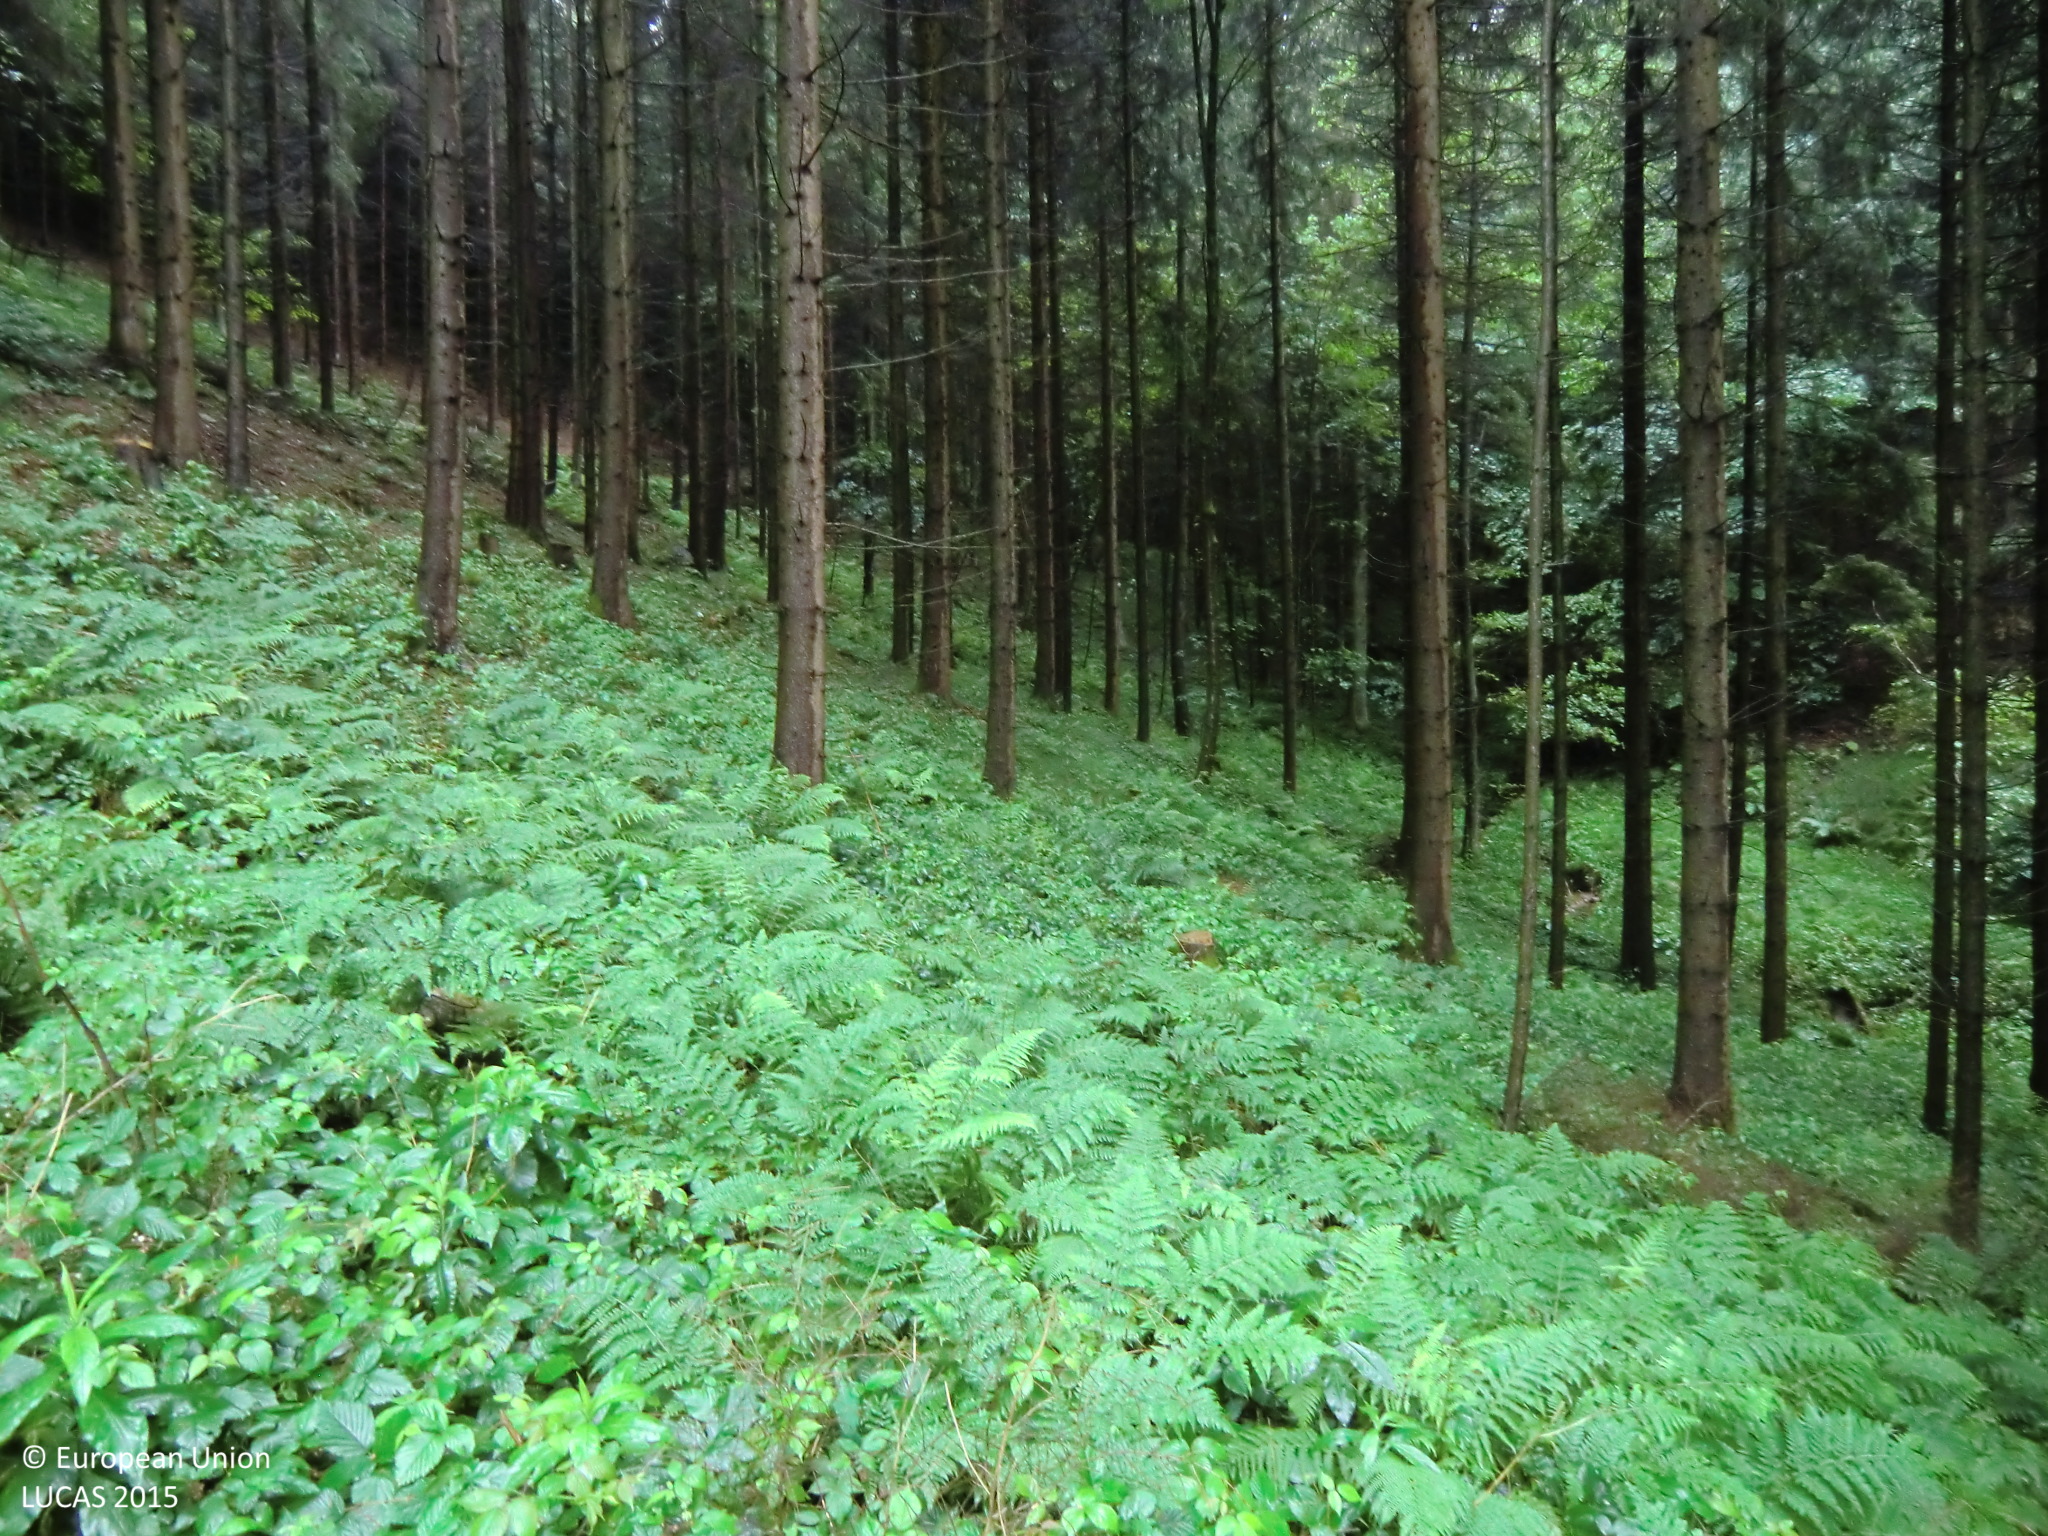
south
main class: Woodland
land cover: Spruce dominated coniferous woodland
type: hemiboreal forest and nemoral coniferous forest and mixed broadleaved-coniferous forest
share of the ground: 50 - 75 %
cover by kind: coniferous forest trees 70 %, herbaceous plants 20 %, lichens and mosses 5 %, unconsolidated bare surface 5 %
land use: Forestry
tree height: > 5 m
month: June
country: AT
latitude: 48.3045
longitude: 14.6790
